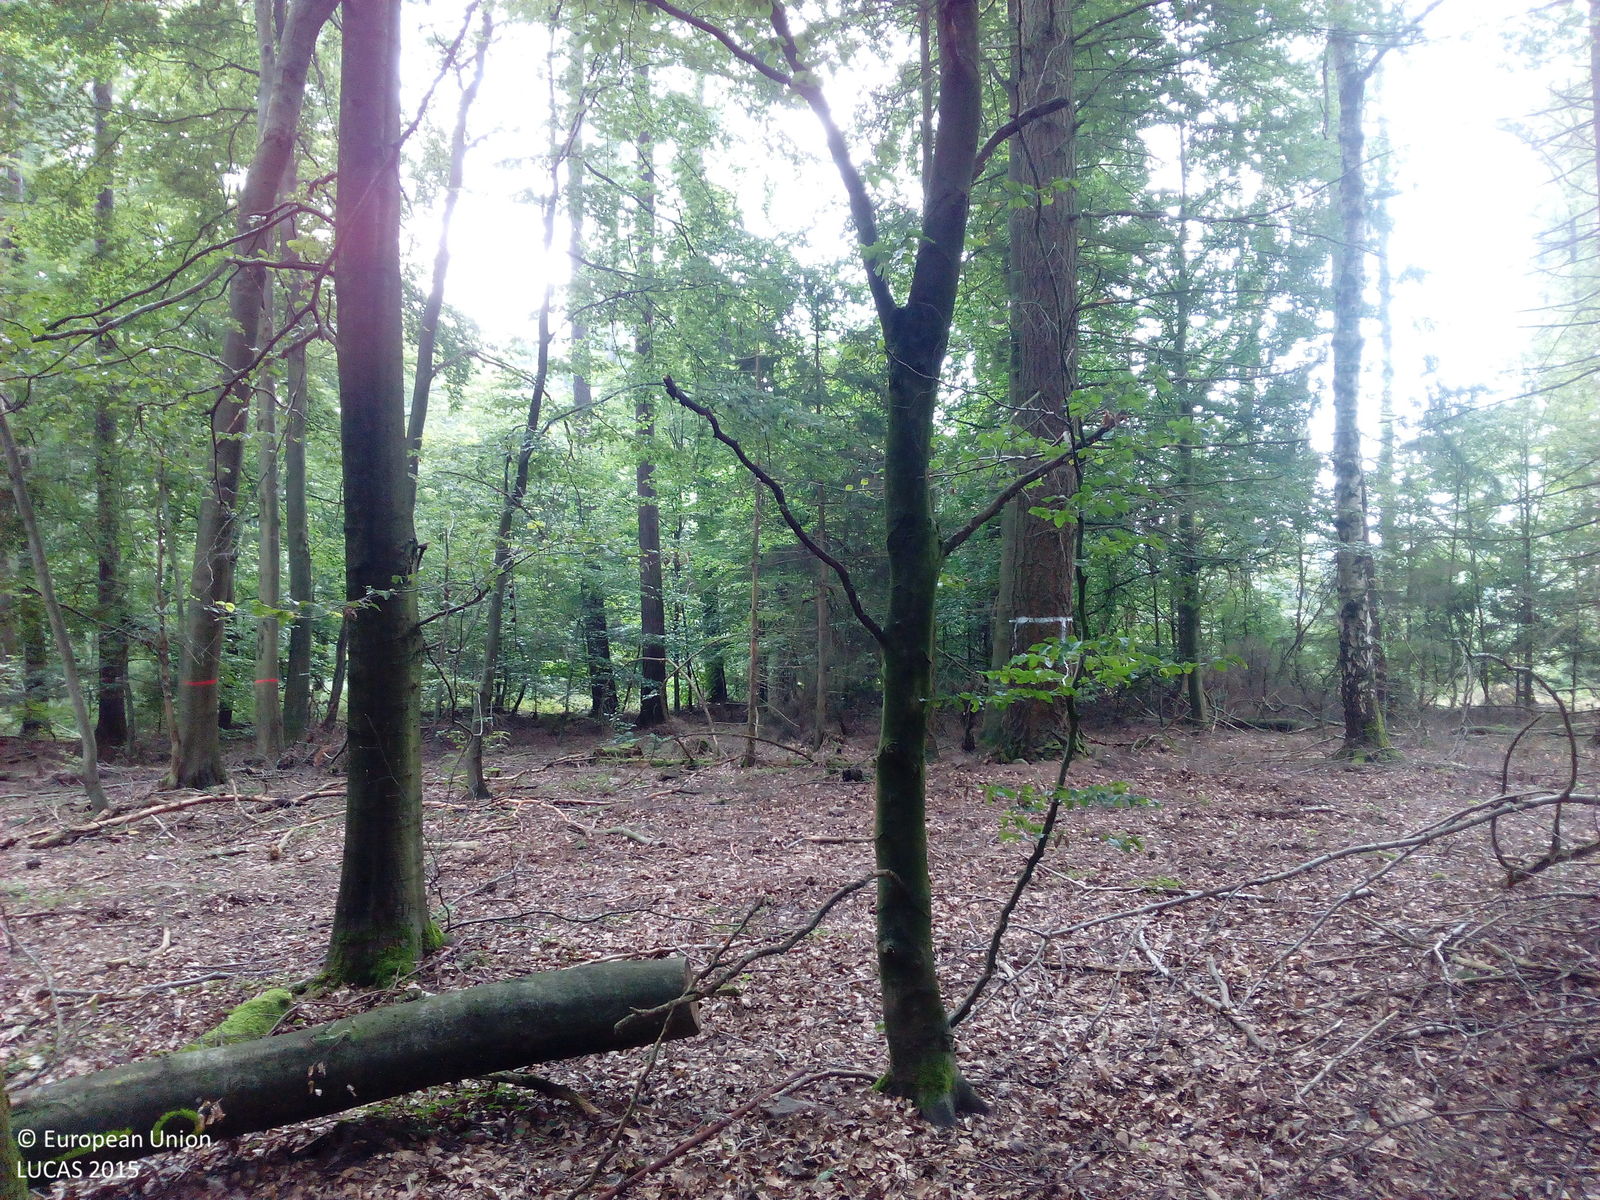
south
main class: Woodland
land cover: Spruce dominated mixed woodland
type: hemiboreal forest and nemoral coniferous forest and mixed broadleaved-coniferous forest
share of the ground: > 75 %
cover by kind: coniferous forest trees 60 %, broadleaved forest trees 40 %
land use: Forestry
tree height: > 5 m
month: September
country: DE
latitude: 51.3887
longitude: 9.8420
